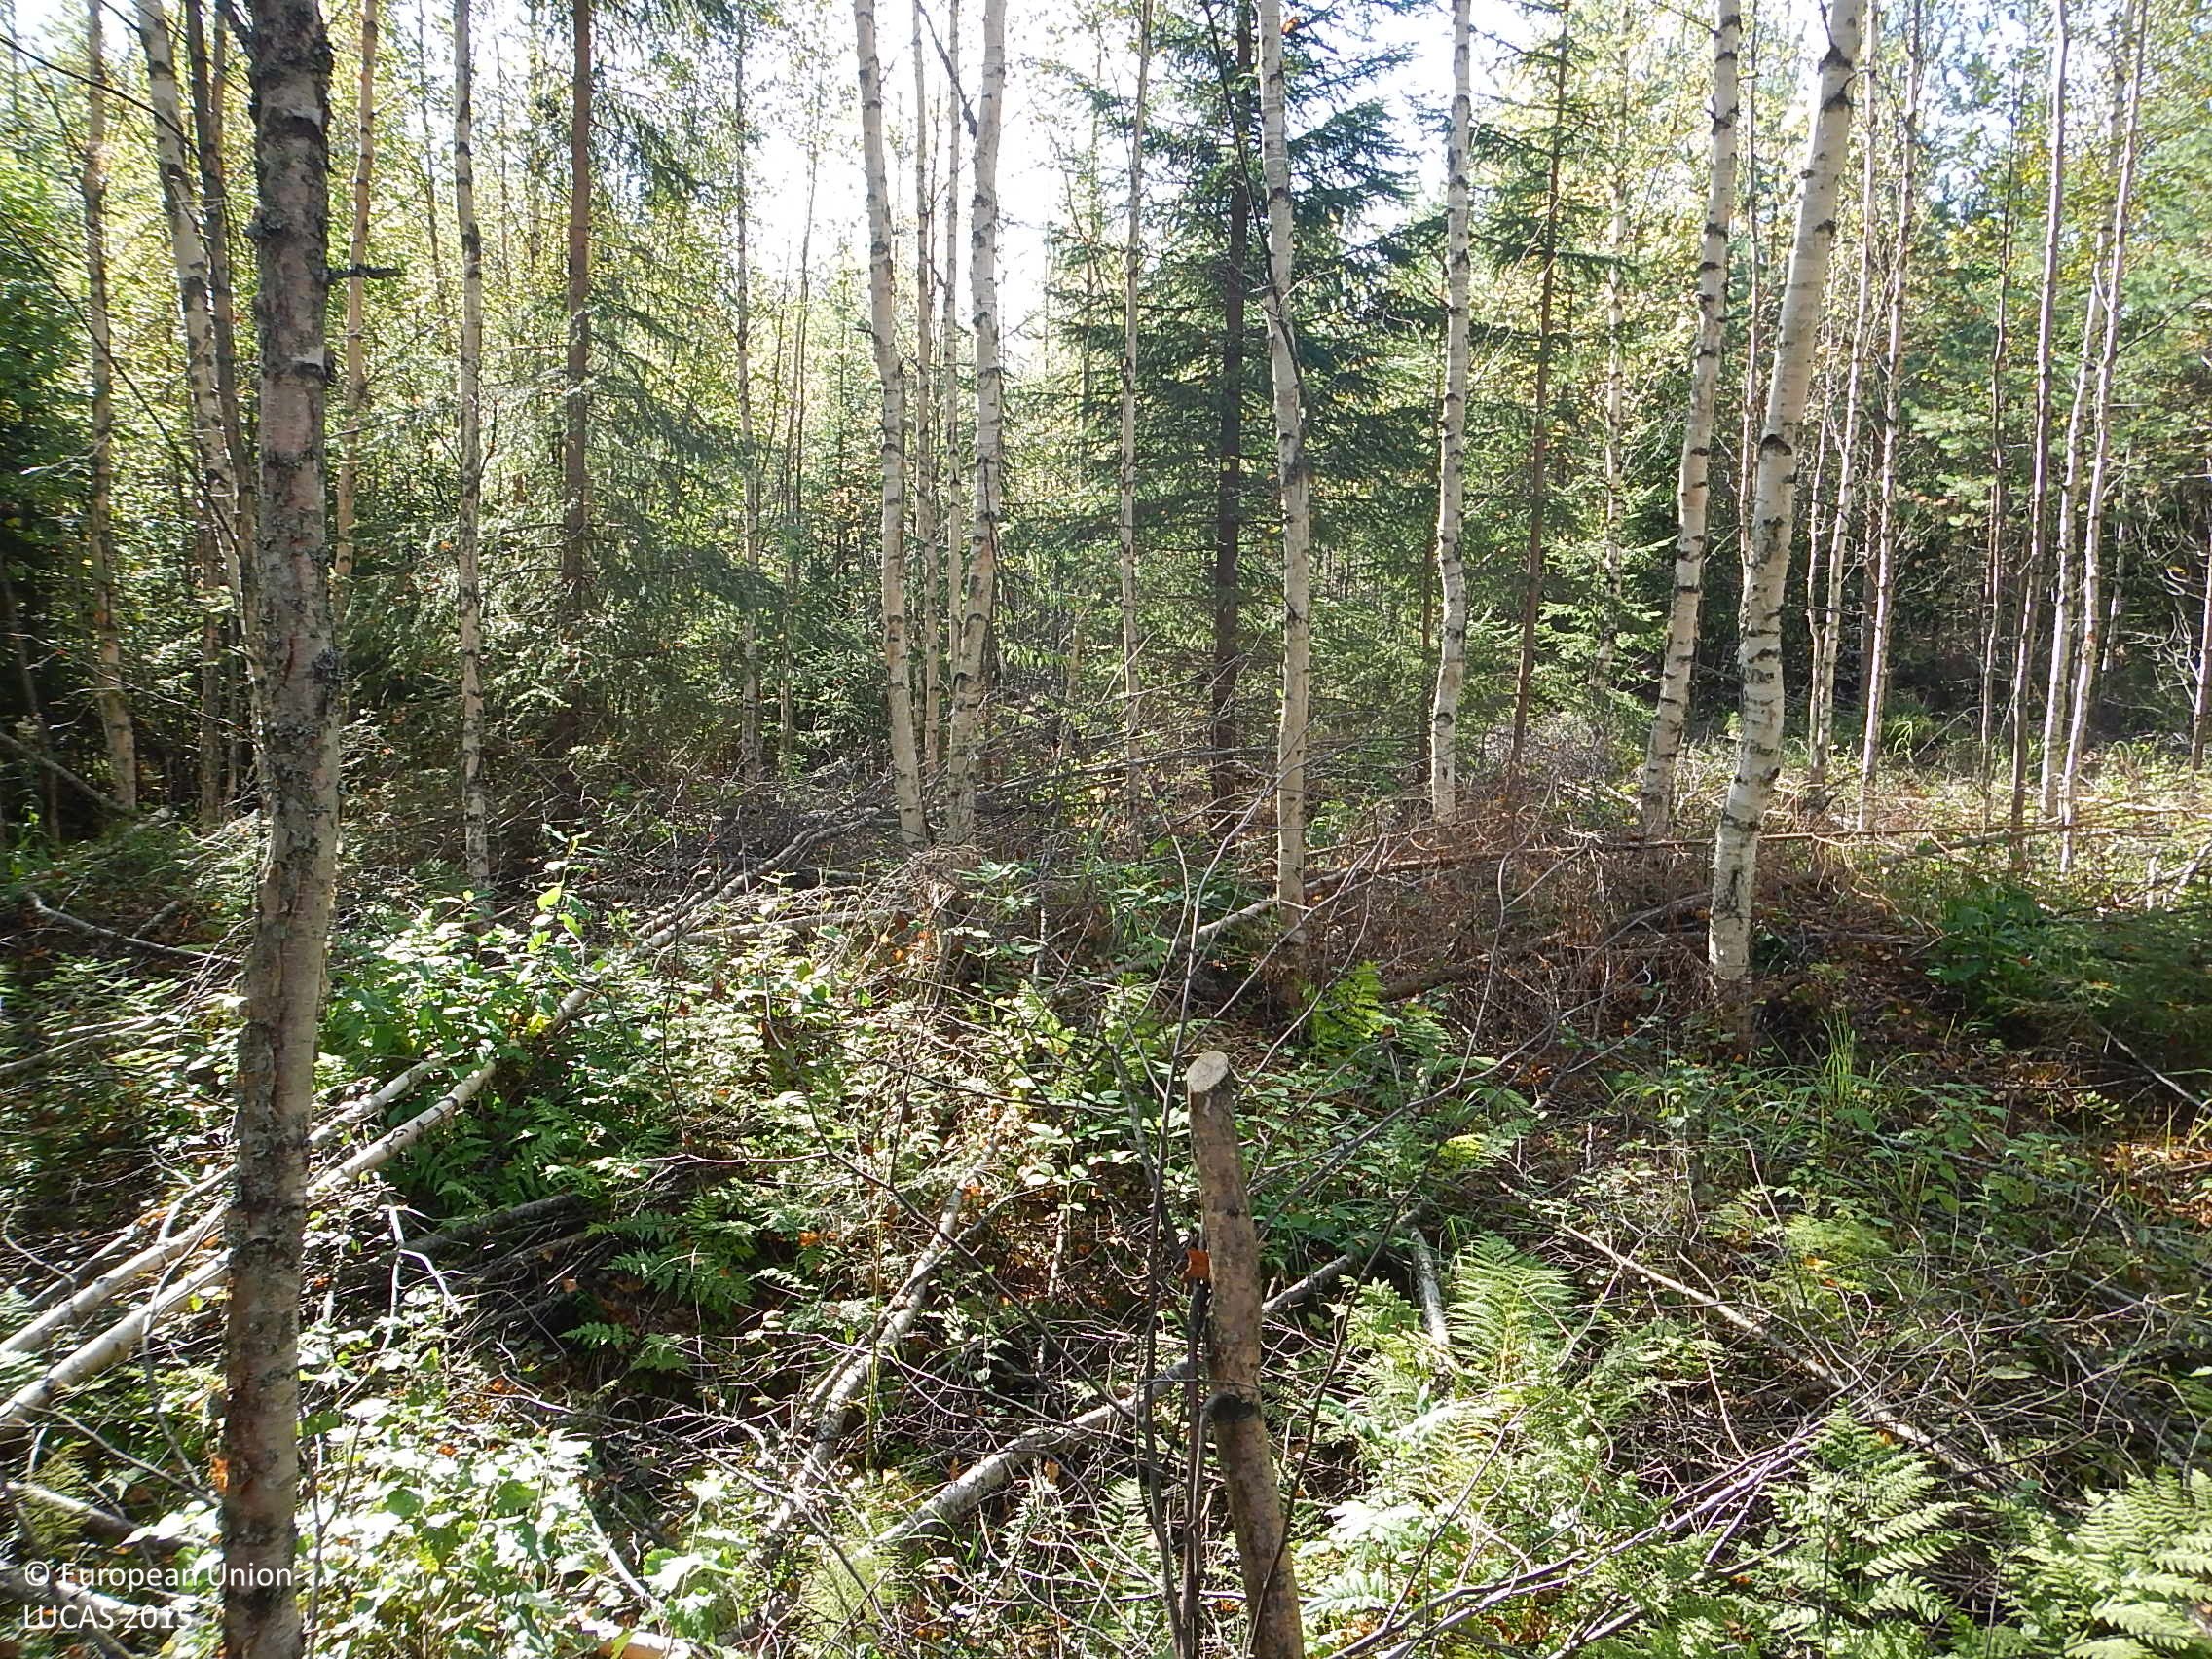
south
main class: Woodland
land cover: Broadleaved woodland
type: boreal forest
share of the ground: 50 - 75 %
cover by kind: broadleaved forest trees 60 %, herbaceous plants 15 %, coniferous forest trees 10 %, lichens and mosses 5 %, unconsolidated bare surface 5 %
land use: Forestry
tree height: > 5 m
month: September
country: FI
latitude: 61.5166
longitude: 22.5641
